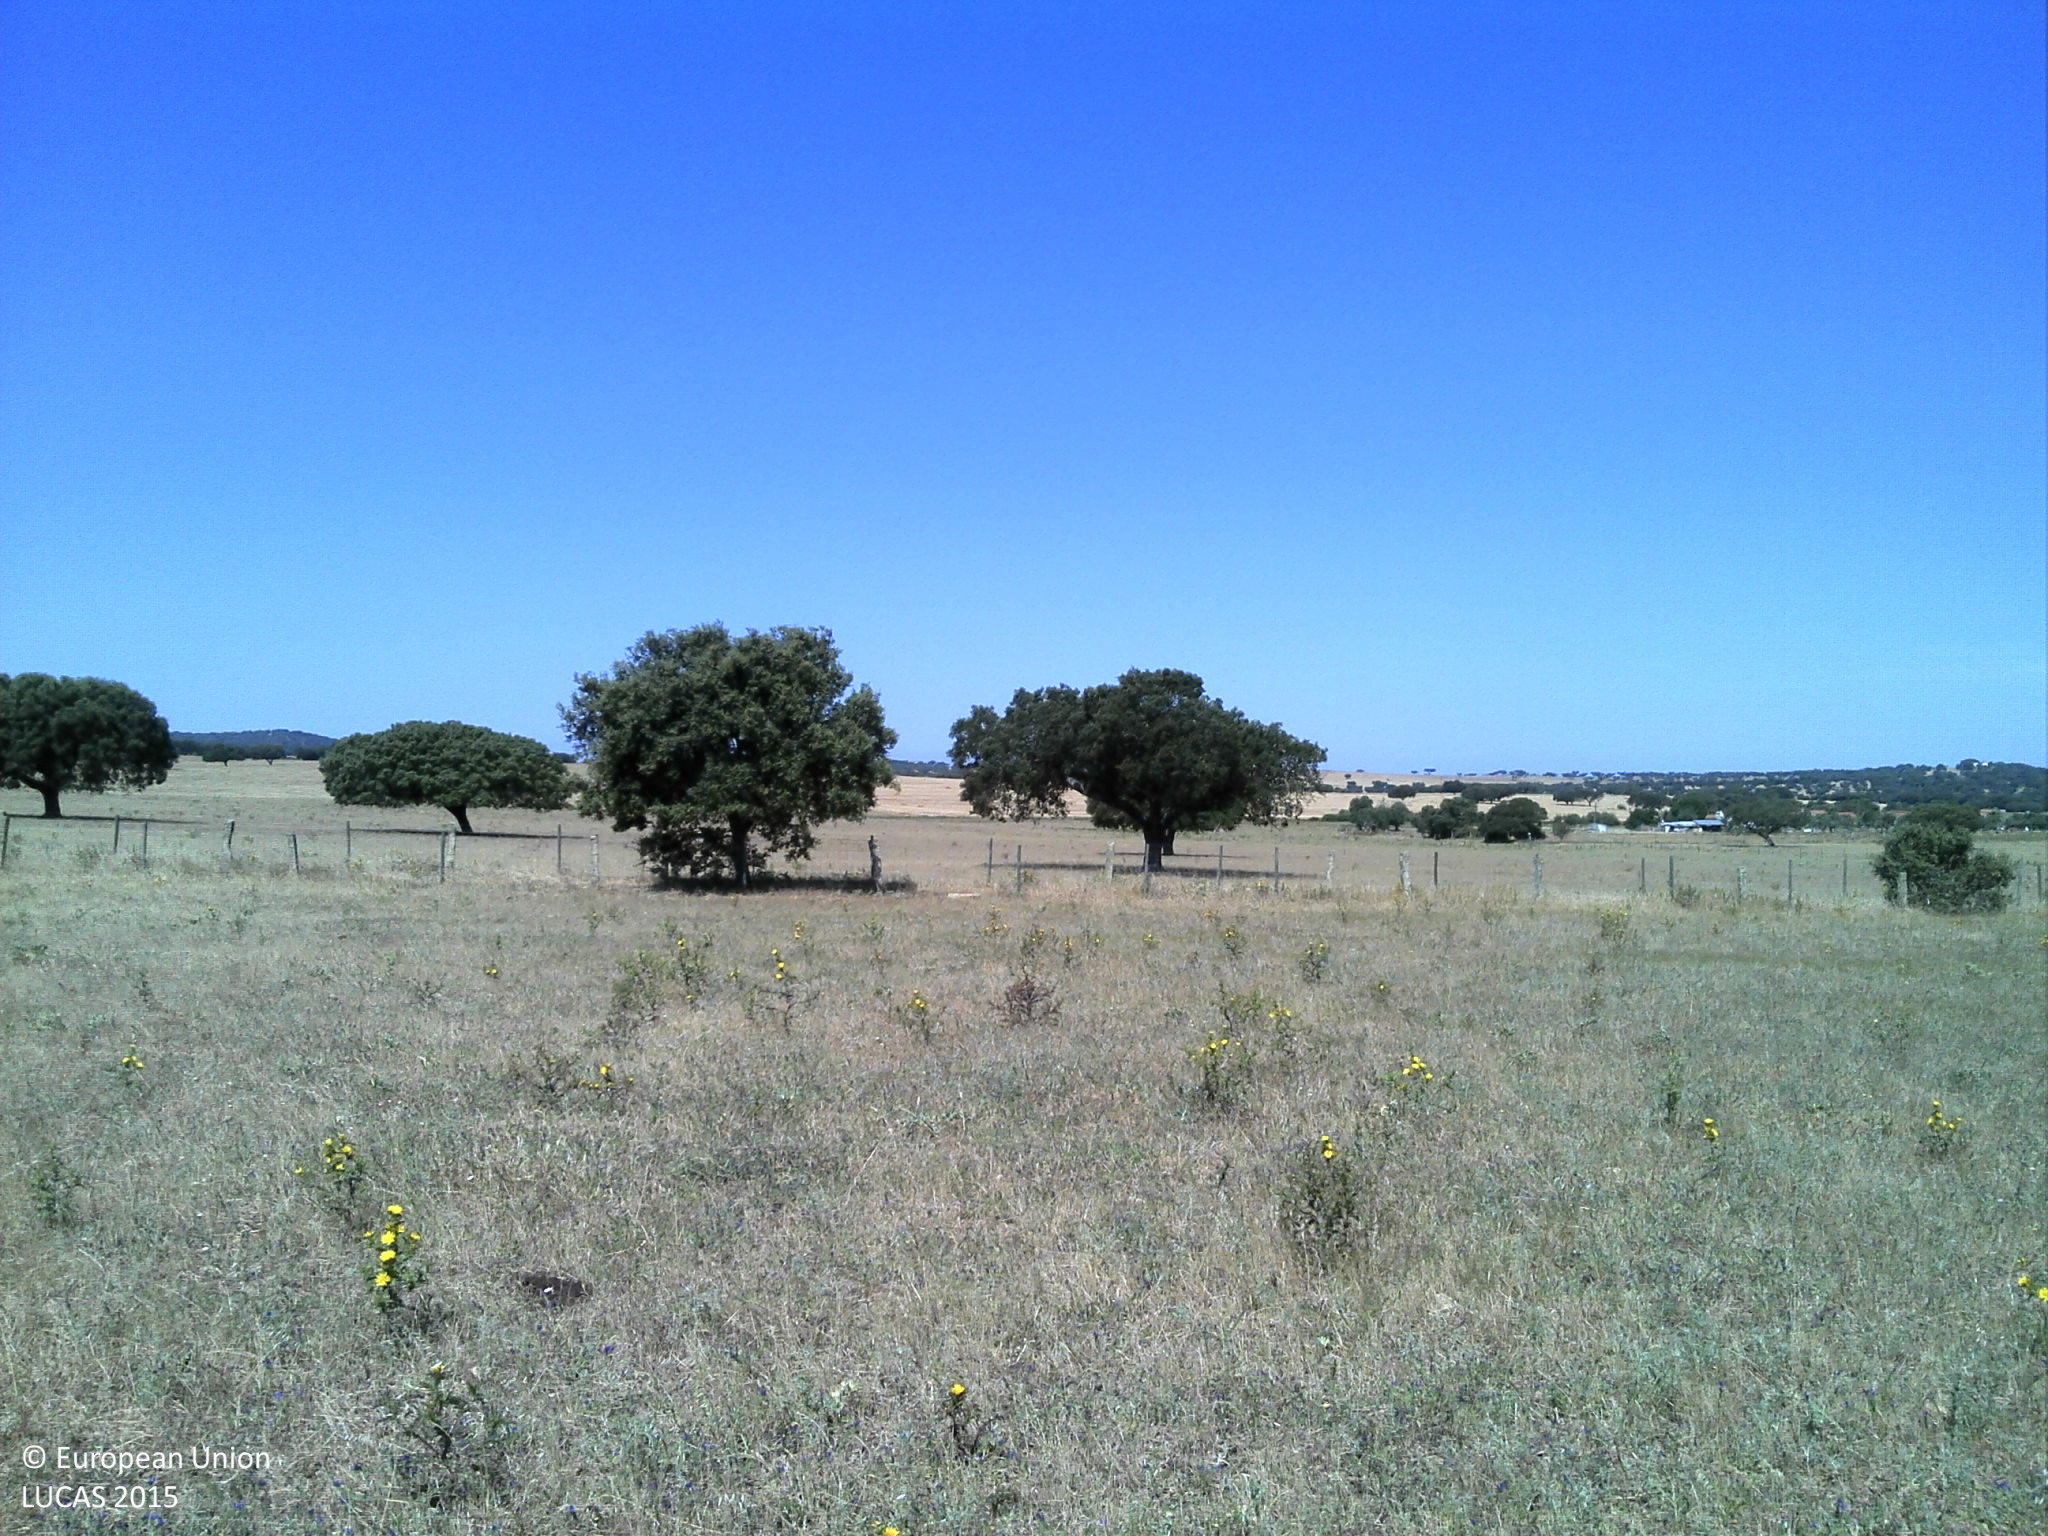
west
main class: Grassland
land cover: Grassland without tree/shrub cover
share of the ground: > 75 %
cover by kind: herbaceous plants 90 %, unconsolidated bare surface 10 %
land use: Agriculture (excluding fallow land and kitchen gardens)
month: June
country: PT
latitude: 38.8034
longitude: -7.8326
